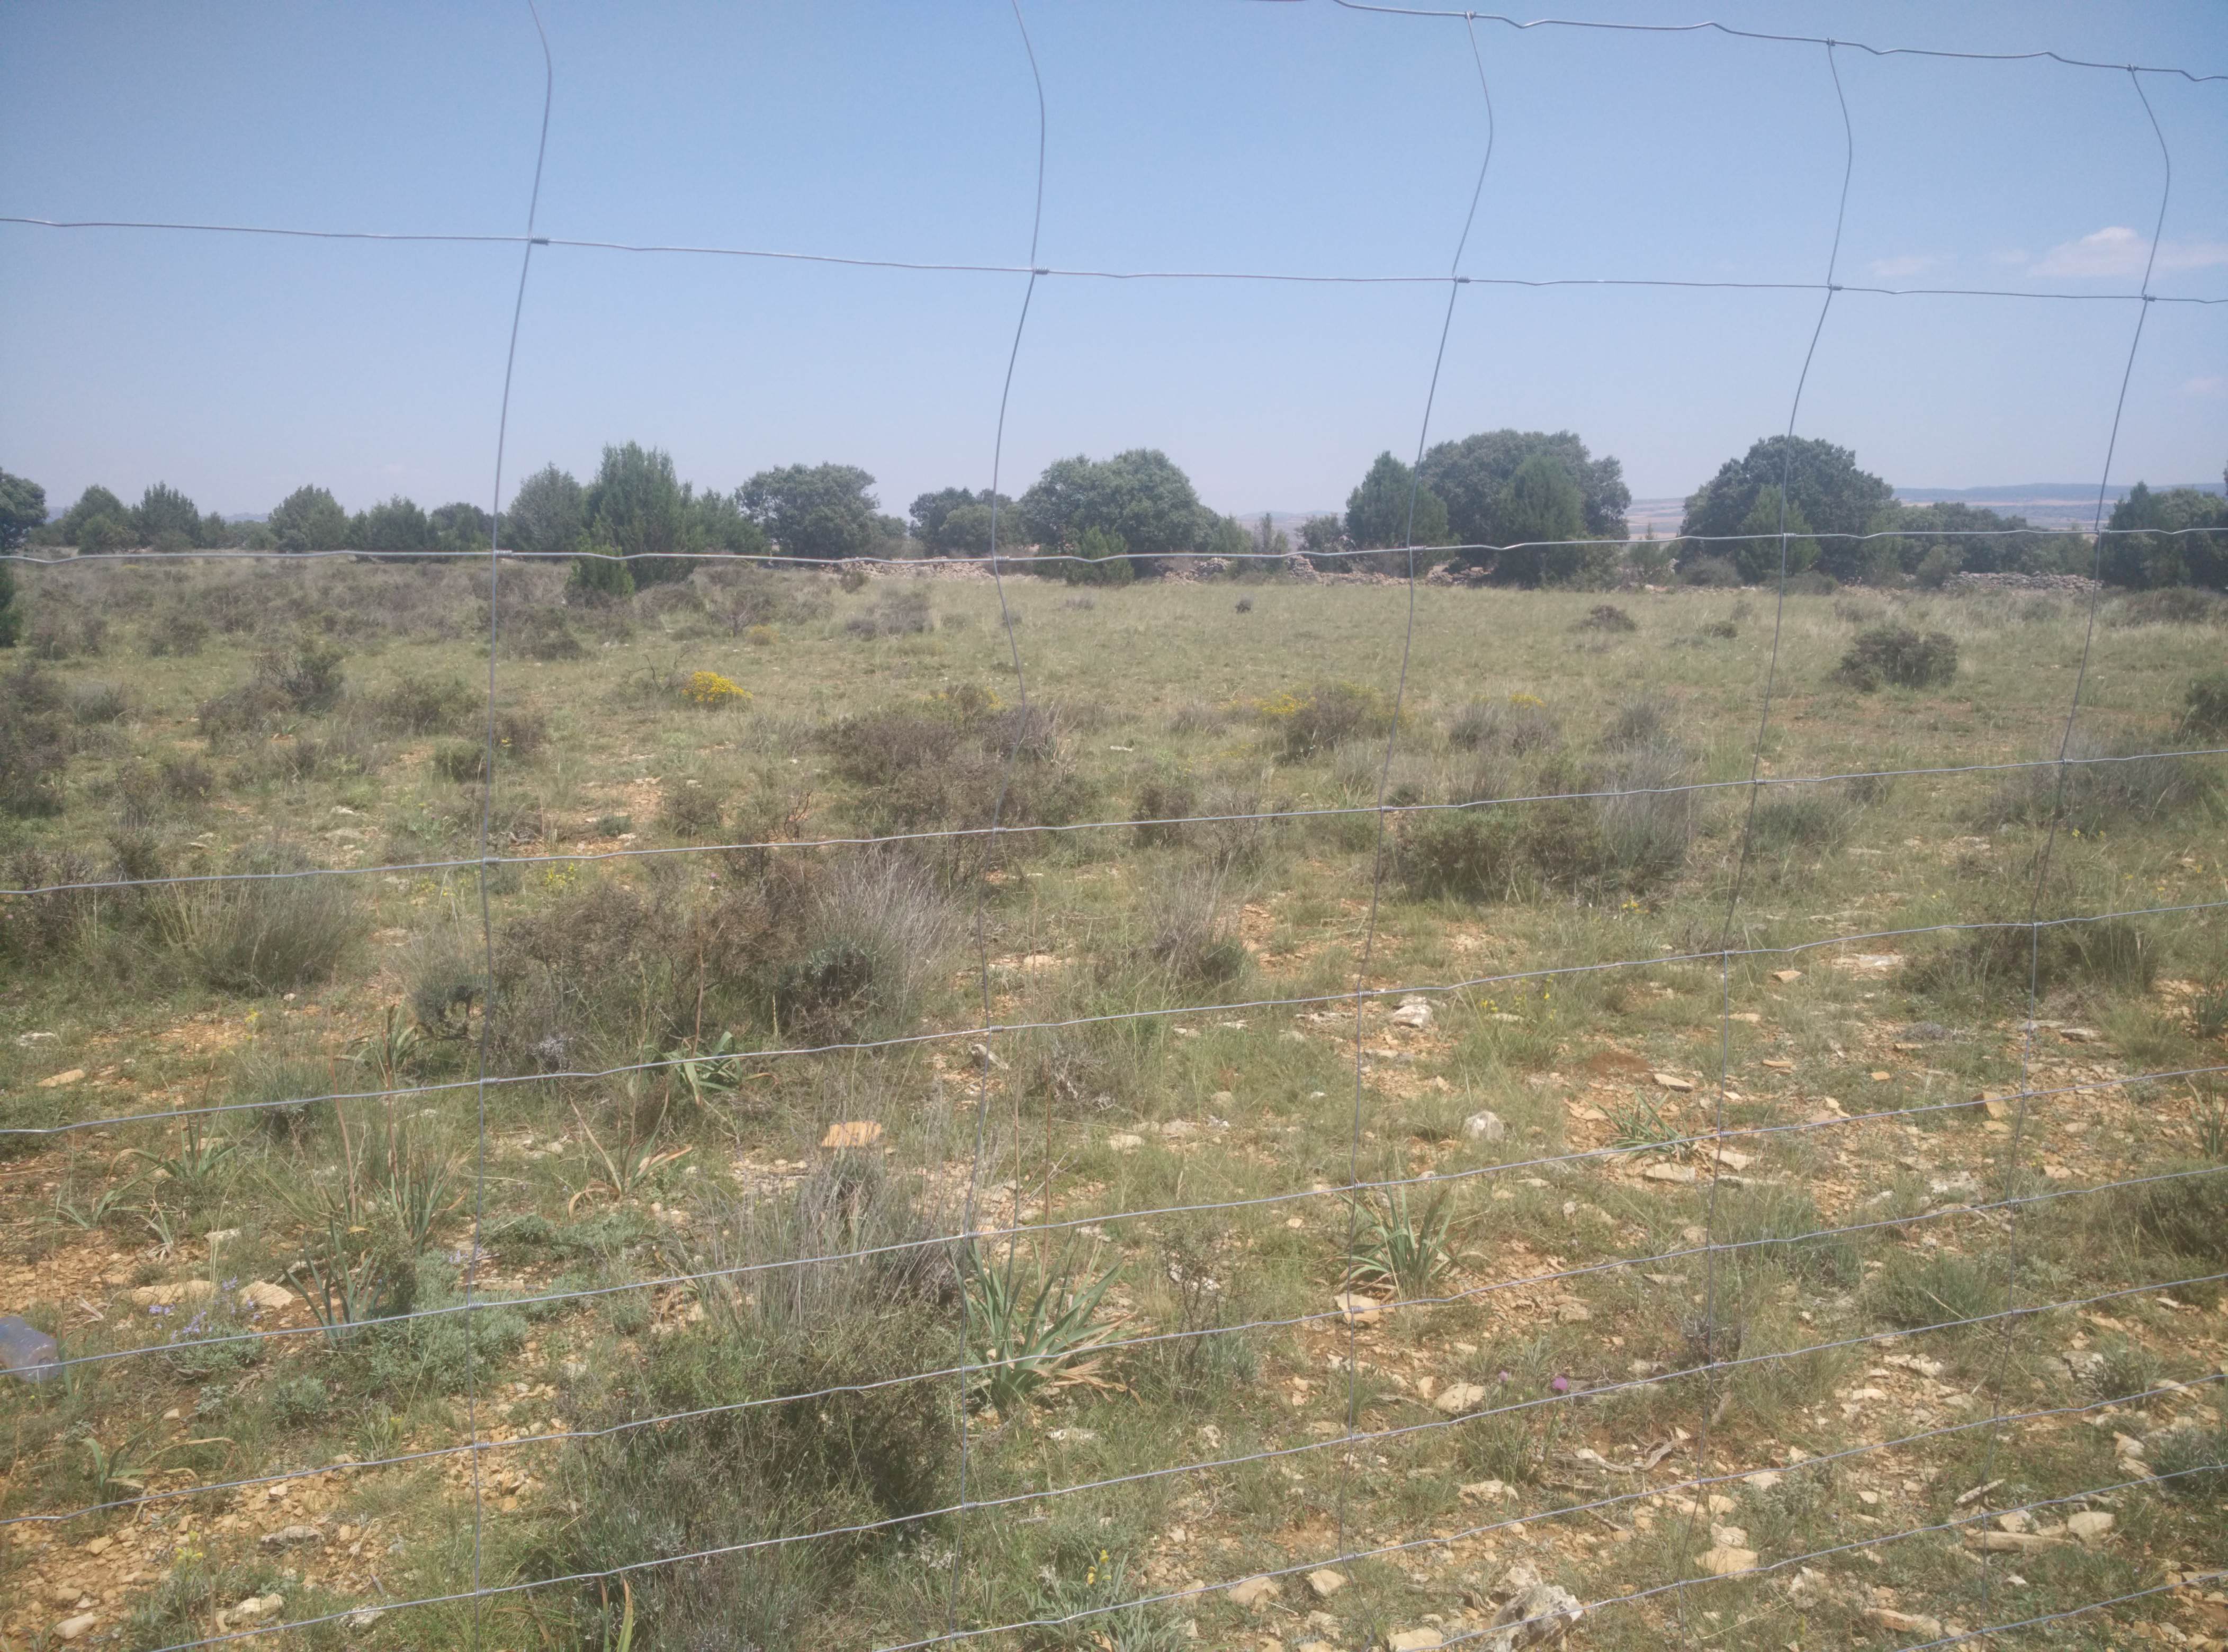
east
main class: Shrubland
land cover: Shrubland without tree cover
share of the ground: 25 - 50 %
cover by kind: unconsolidated bare surface 55 %, shrubs 30 %, herbaceous plants 15 %
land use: Agriculture (excluding fallow land and kitchen gardens)
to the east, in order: Shrubland without tree cover; Shrubland with sparse tree cover; Shrubland without tree cover
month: June
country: ES
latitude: 40.7870
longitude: -1.8599
